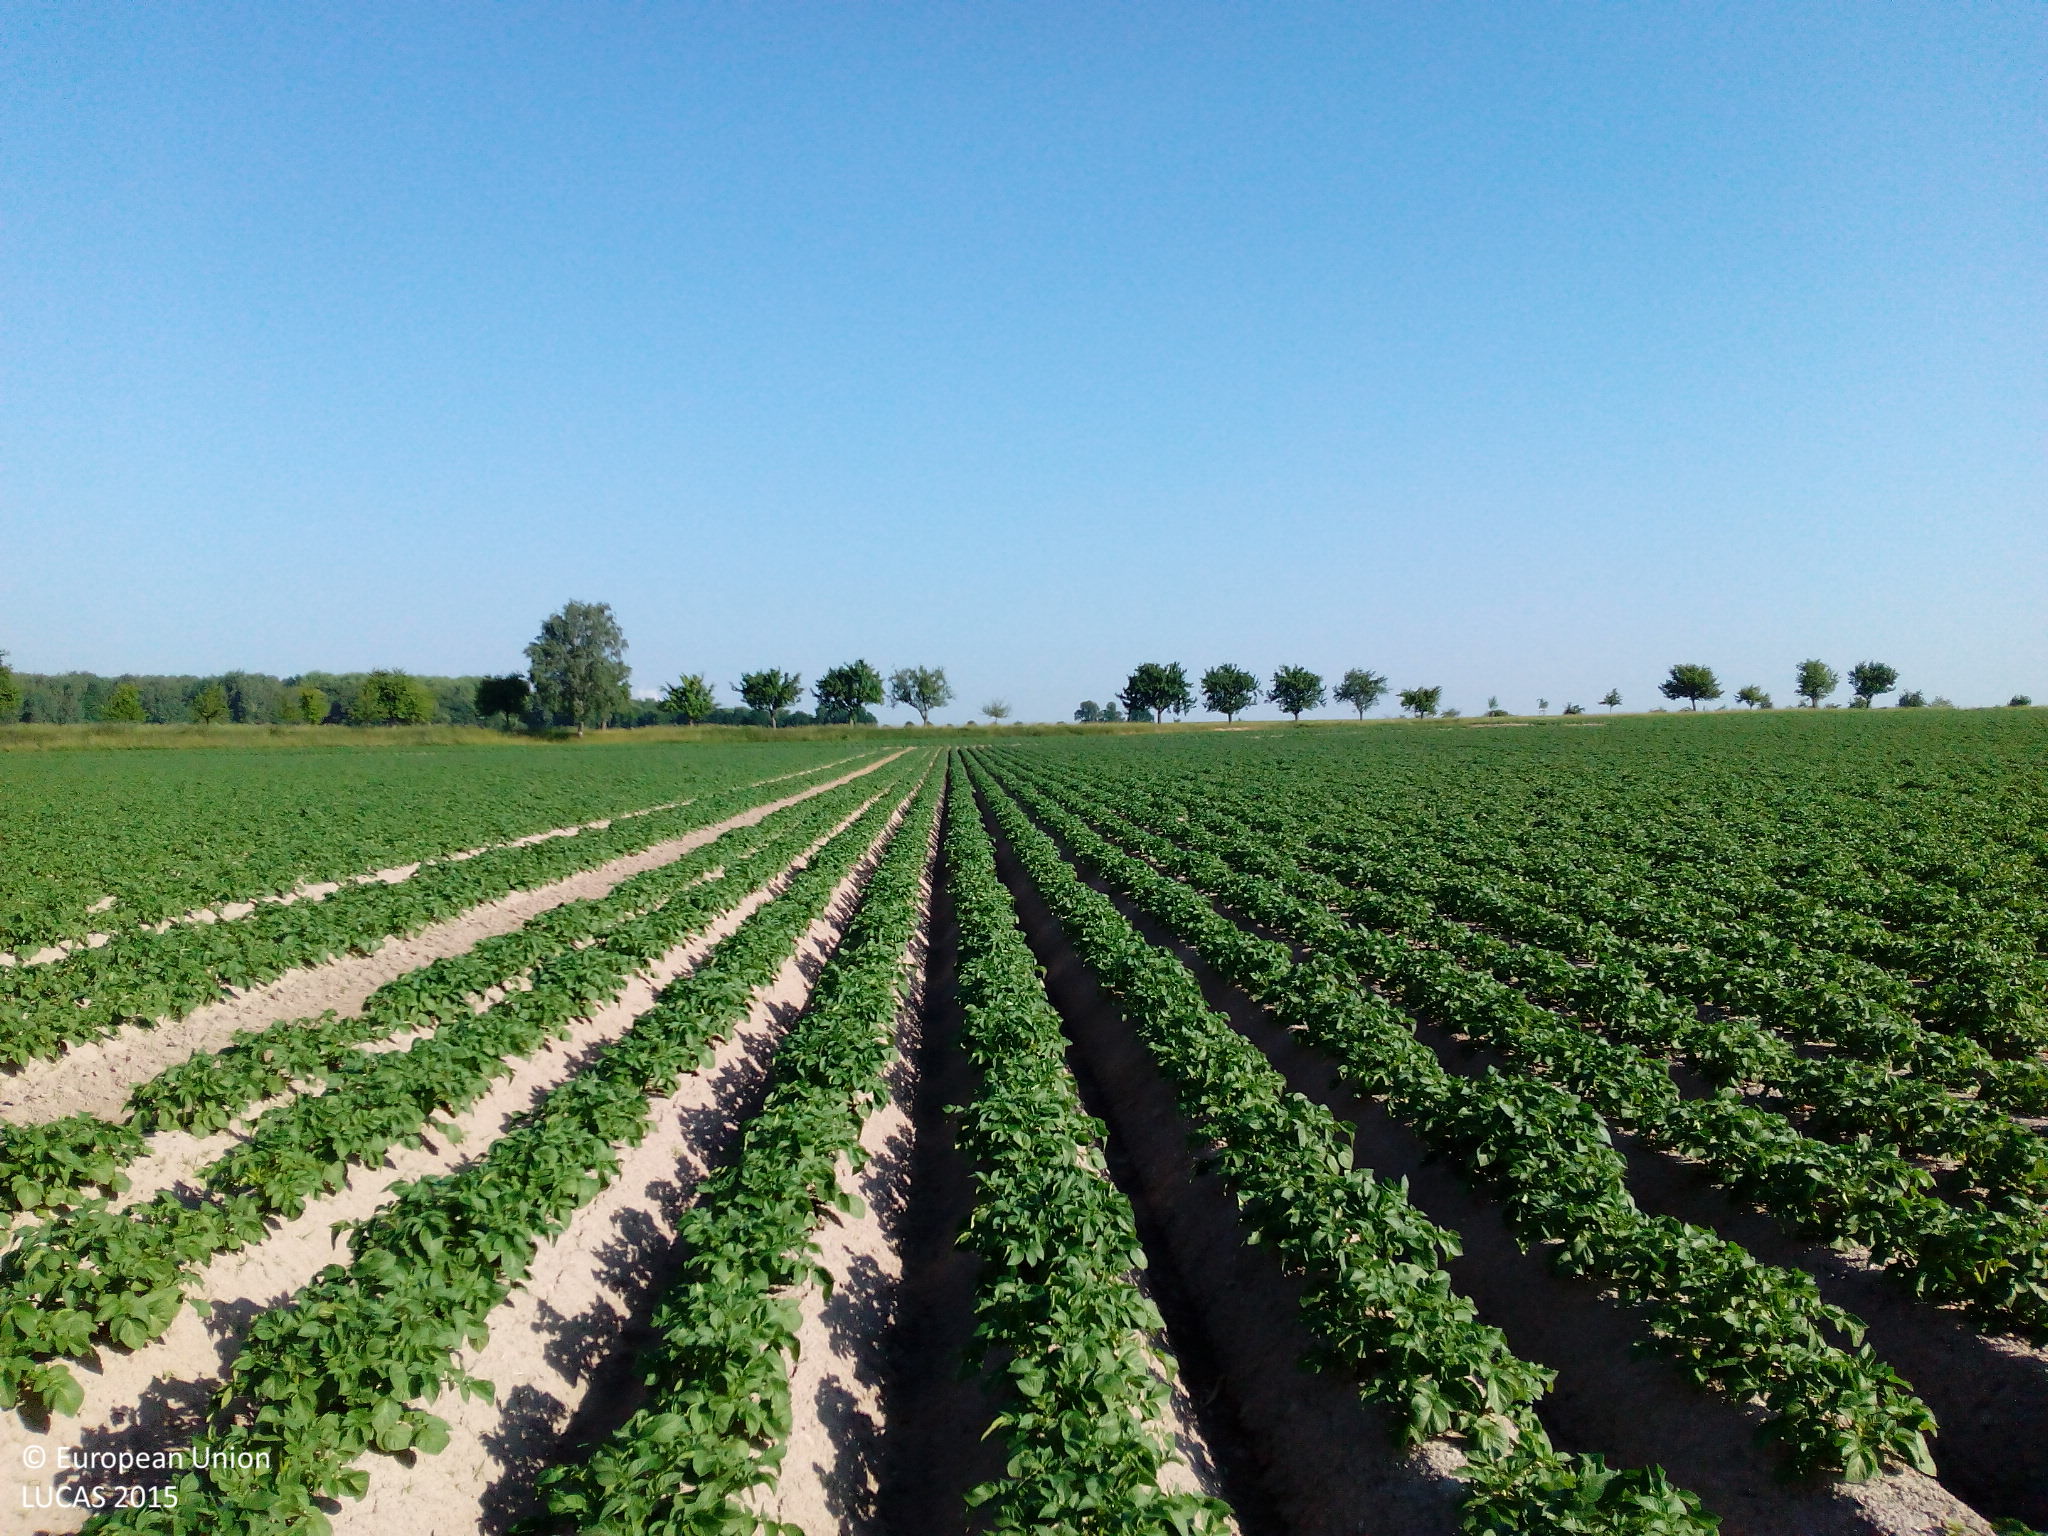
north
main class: Cropland
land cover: Potatoes
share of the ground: 50 - 75 %
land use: Agriculture (excluding fallow land and kitchen gardens)
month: June
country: DE
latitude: 51.0557
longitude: 12.5250
